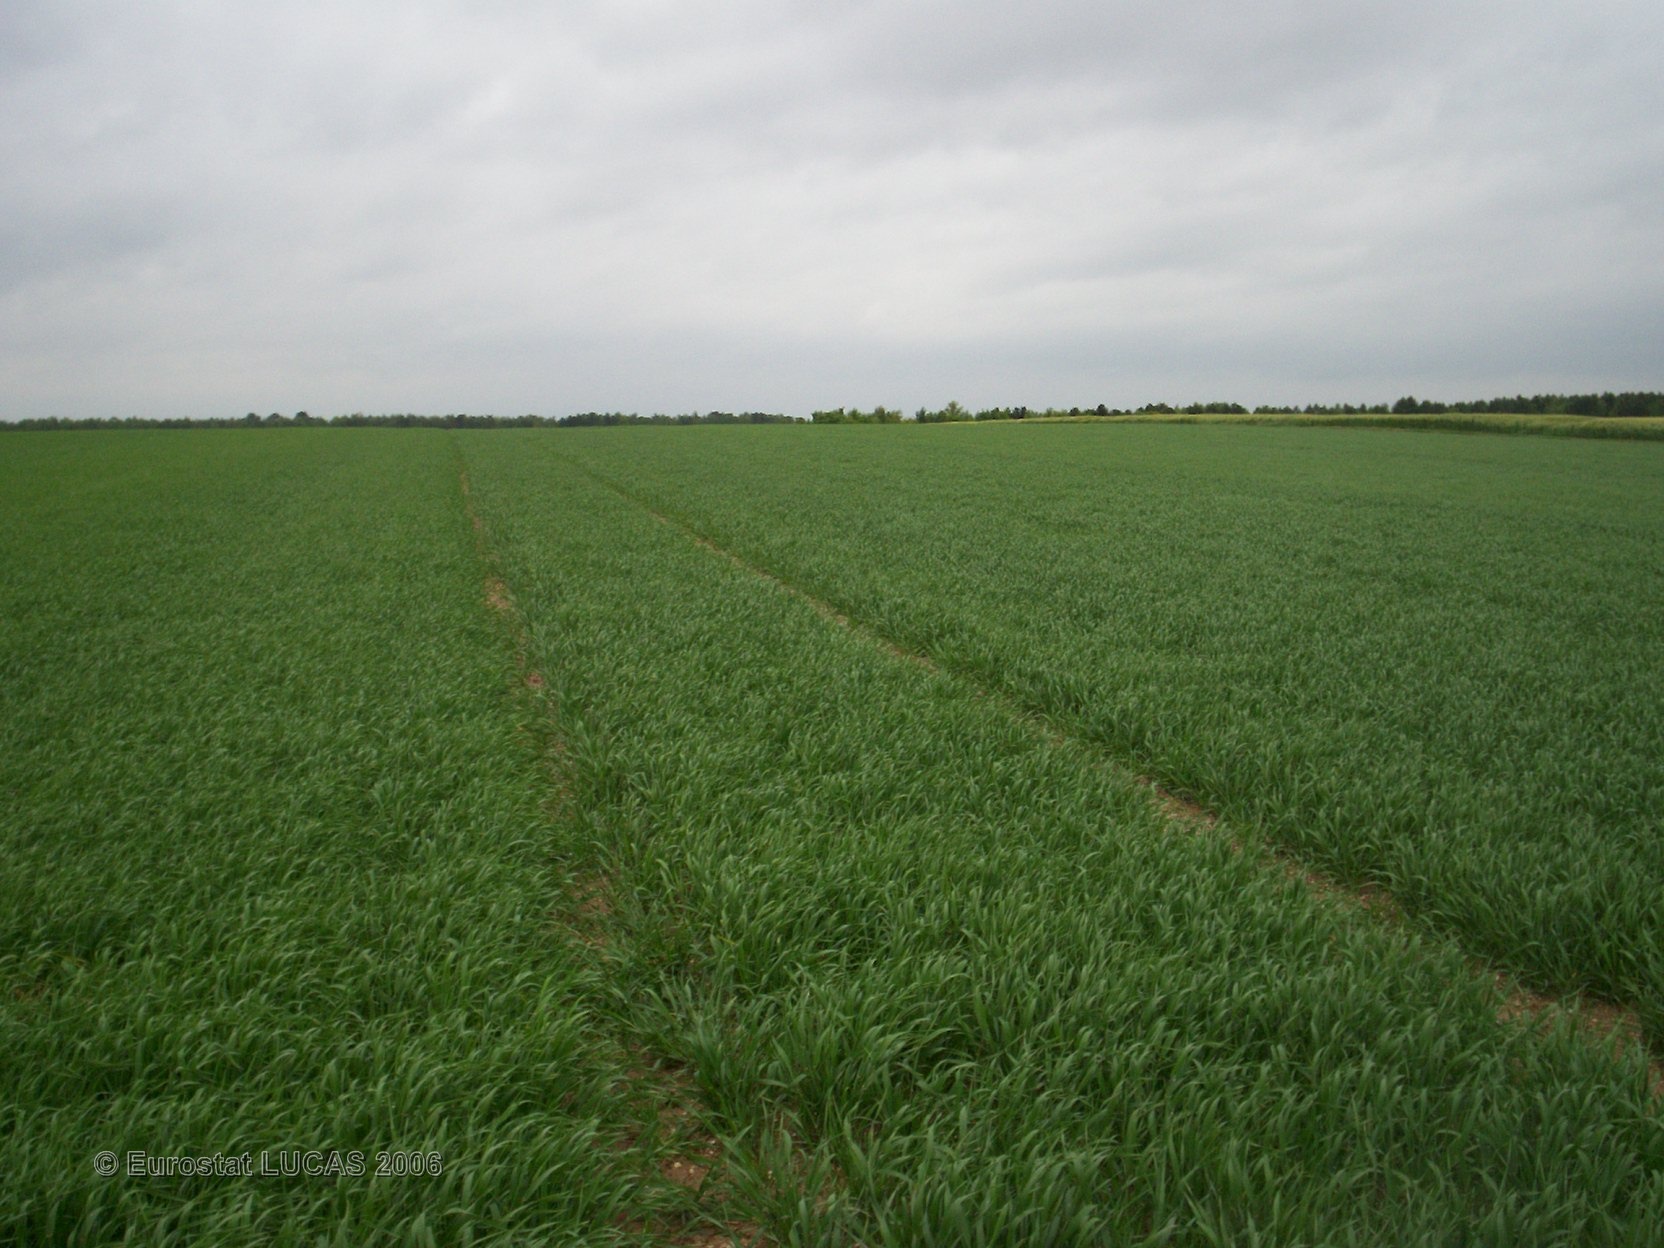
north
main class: Cropland
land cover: Barley
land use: Agriculture (excluding fallow land and kitchen gardens)
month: May
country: FR
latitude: 49.3102
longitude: 4.4531
